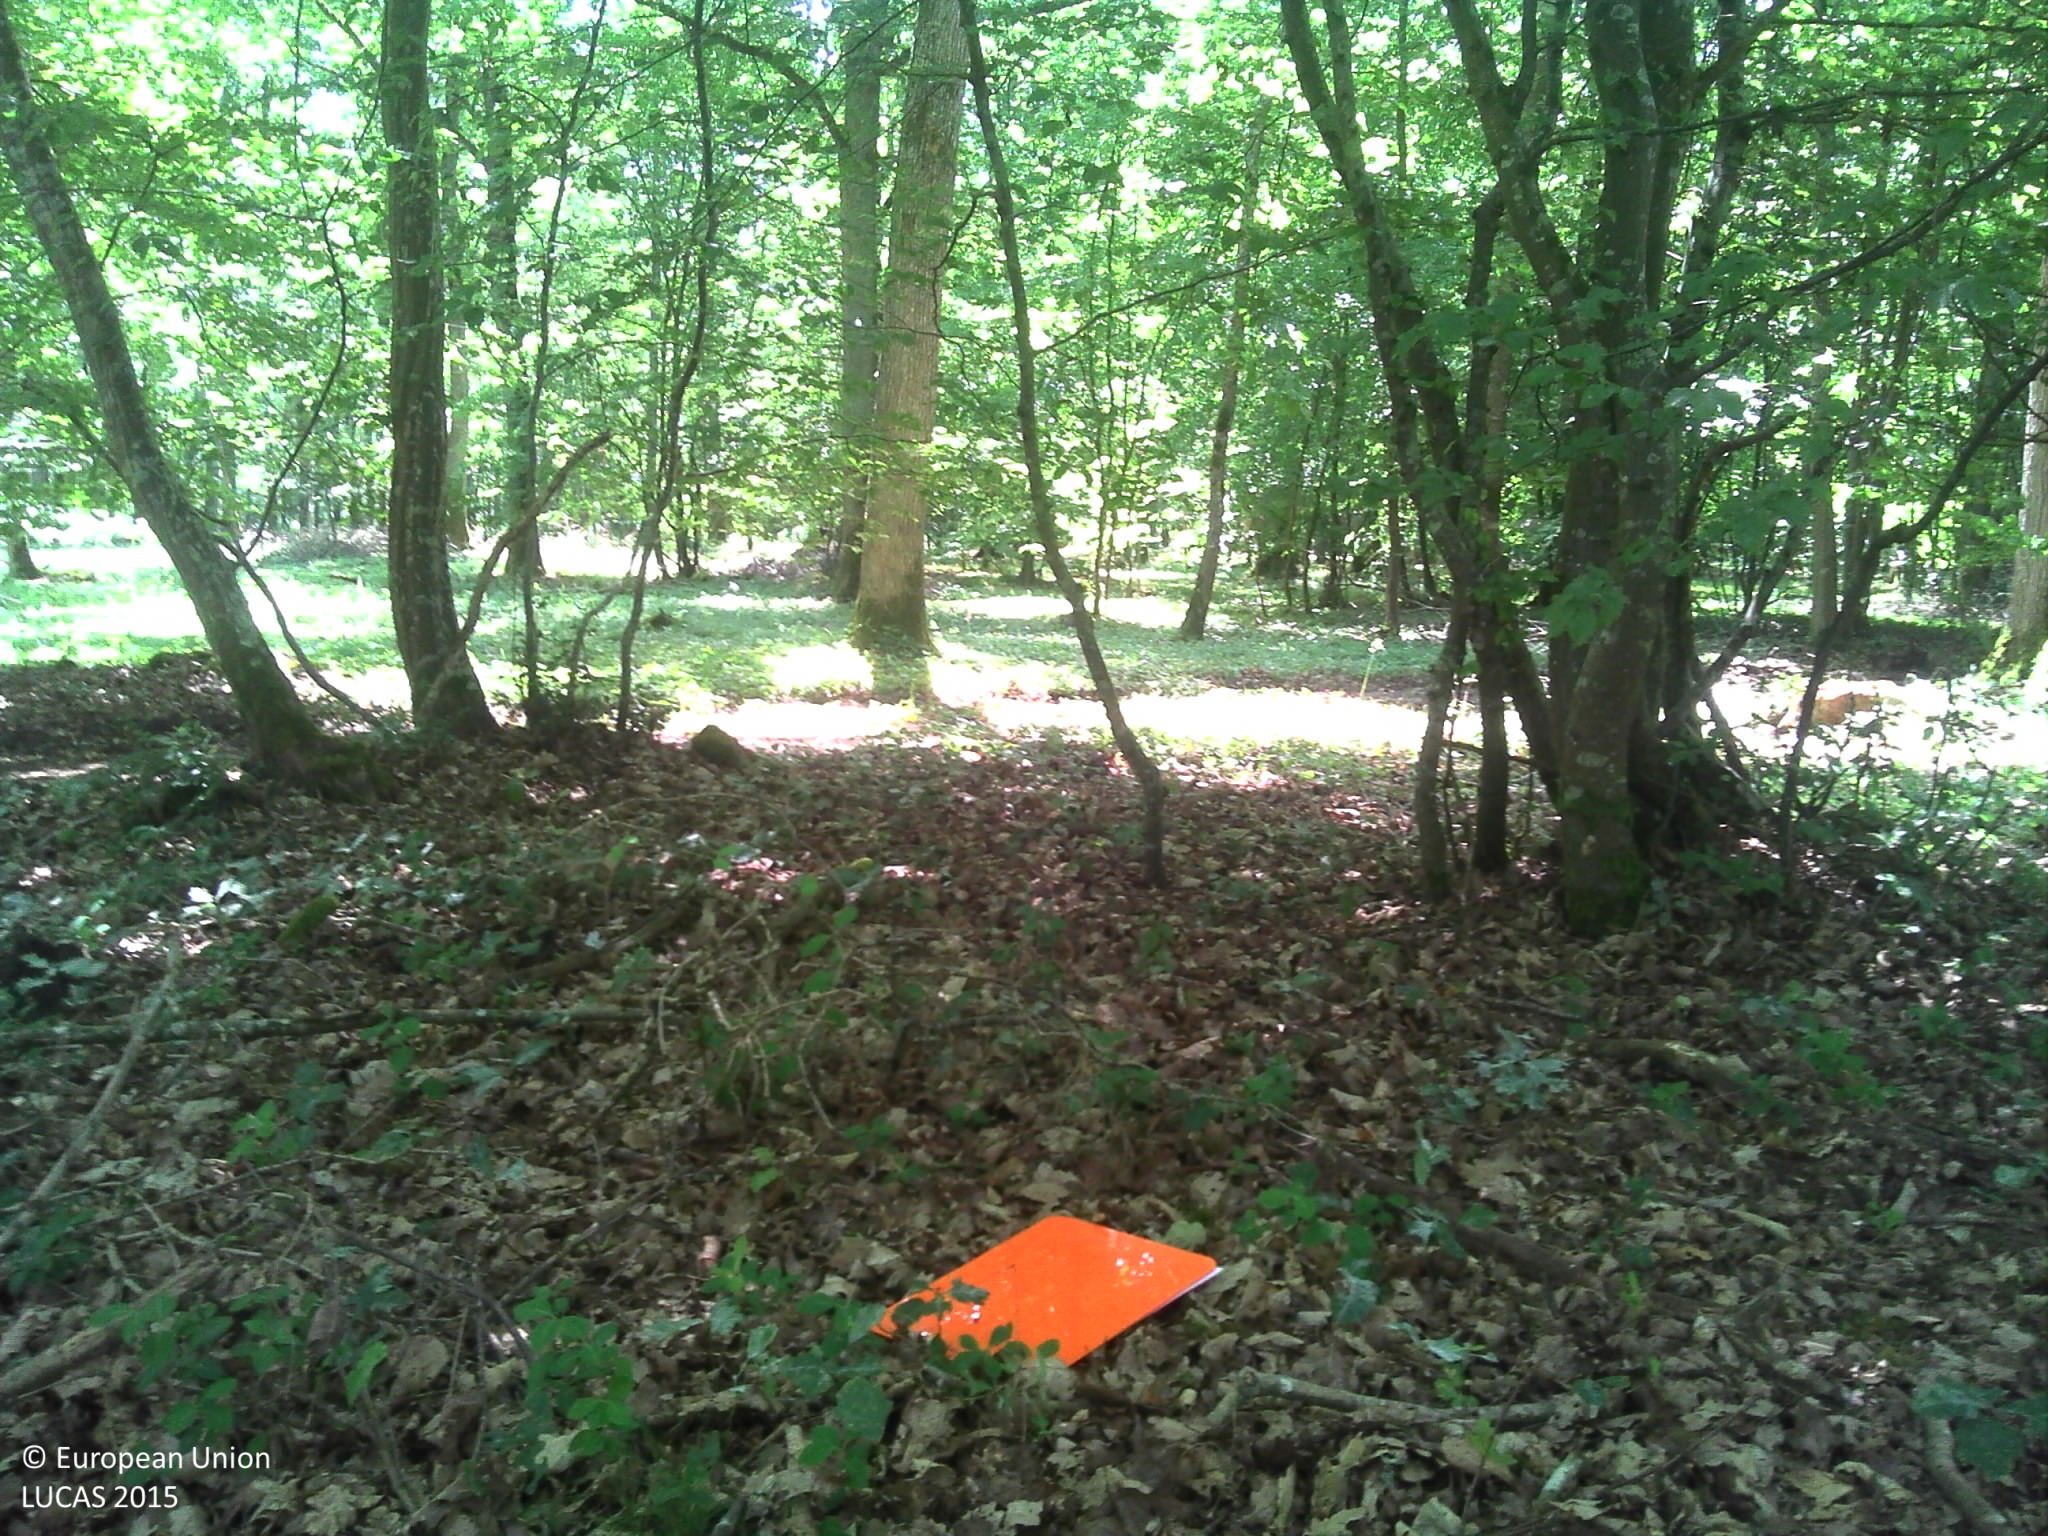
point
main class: Woodland
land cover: Broadleaved woodland
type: mesophytic deciduous forest
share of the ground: > 75 %
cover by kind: broadleaved forest trees 80 %, herbaceous plants 10 %, lichens and mosses 10 %
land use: Forestry
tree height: > 5 m
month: June
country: FR
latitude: 48.6156
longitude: 1.2318
